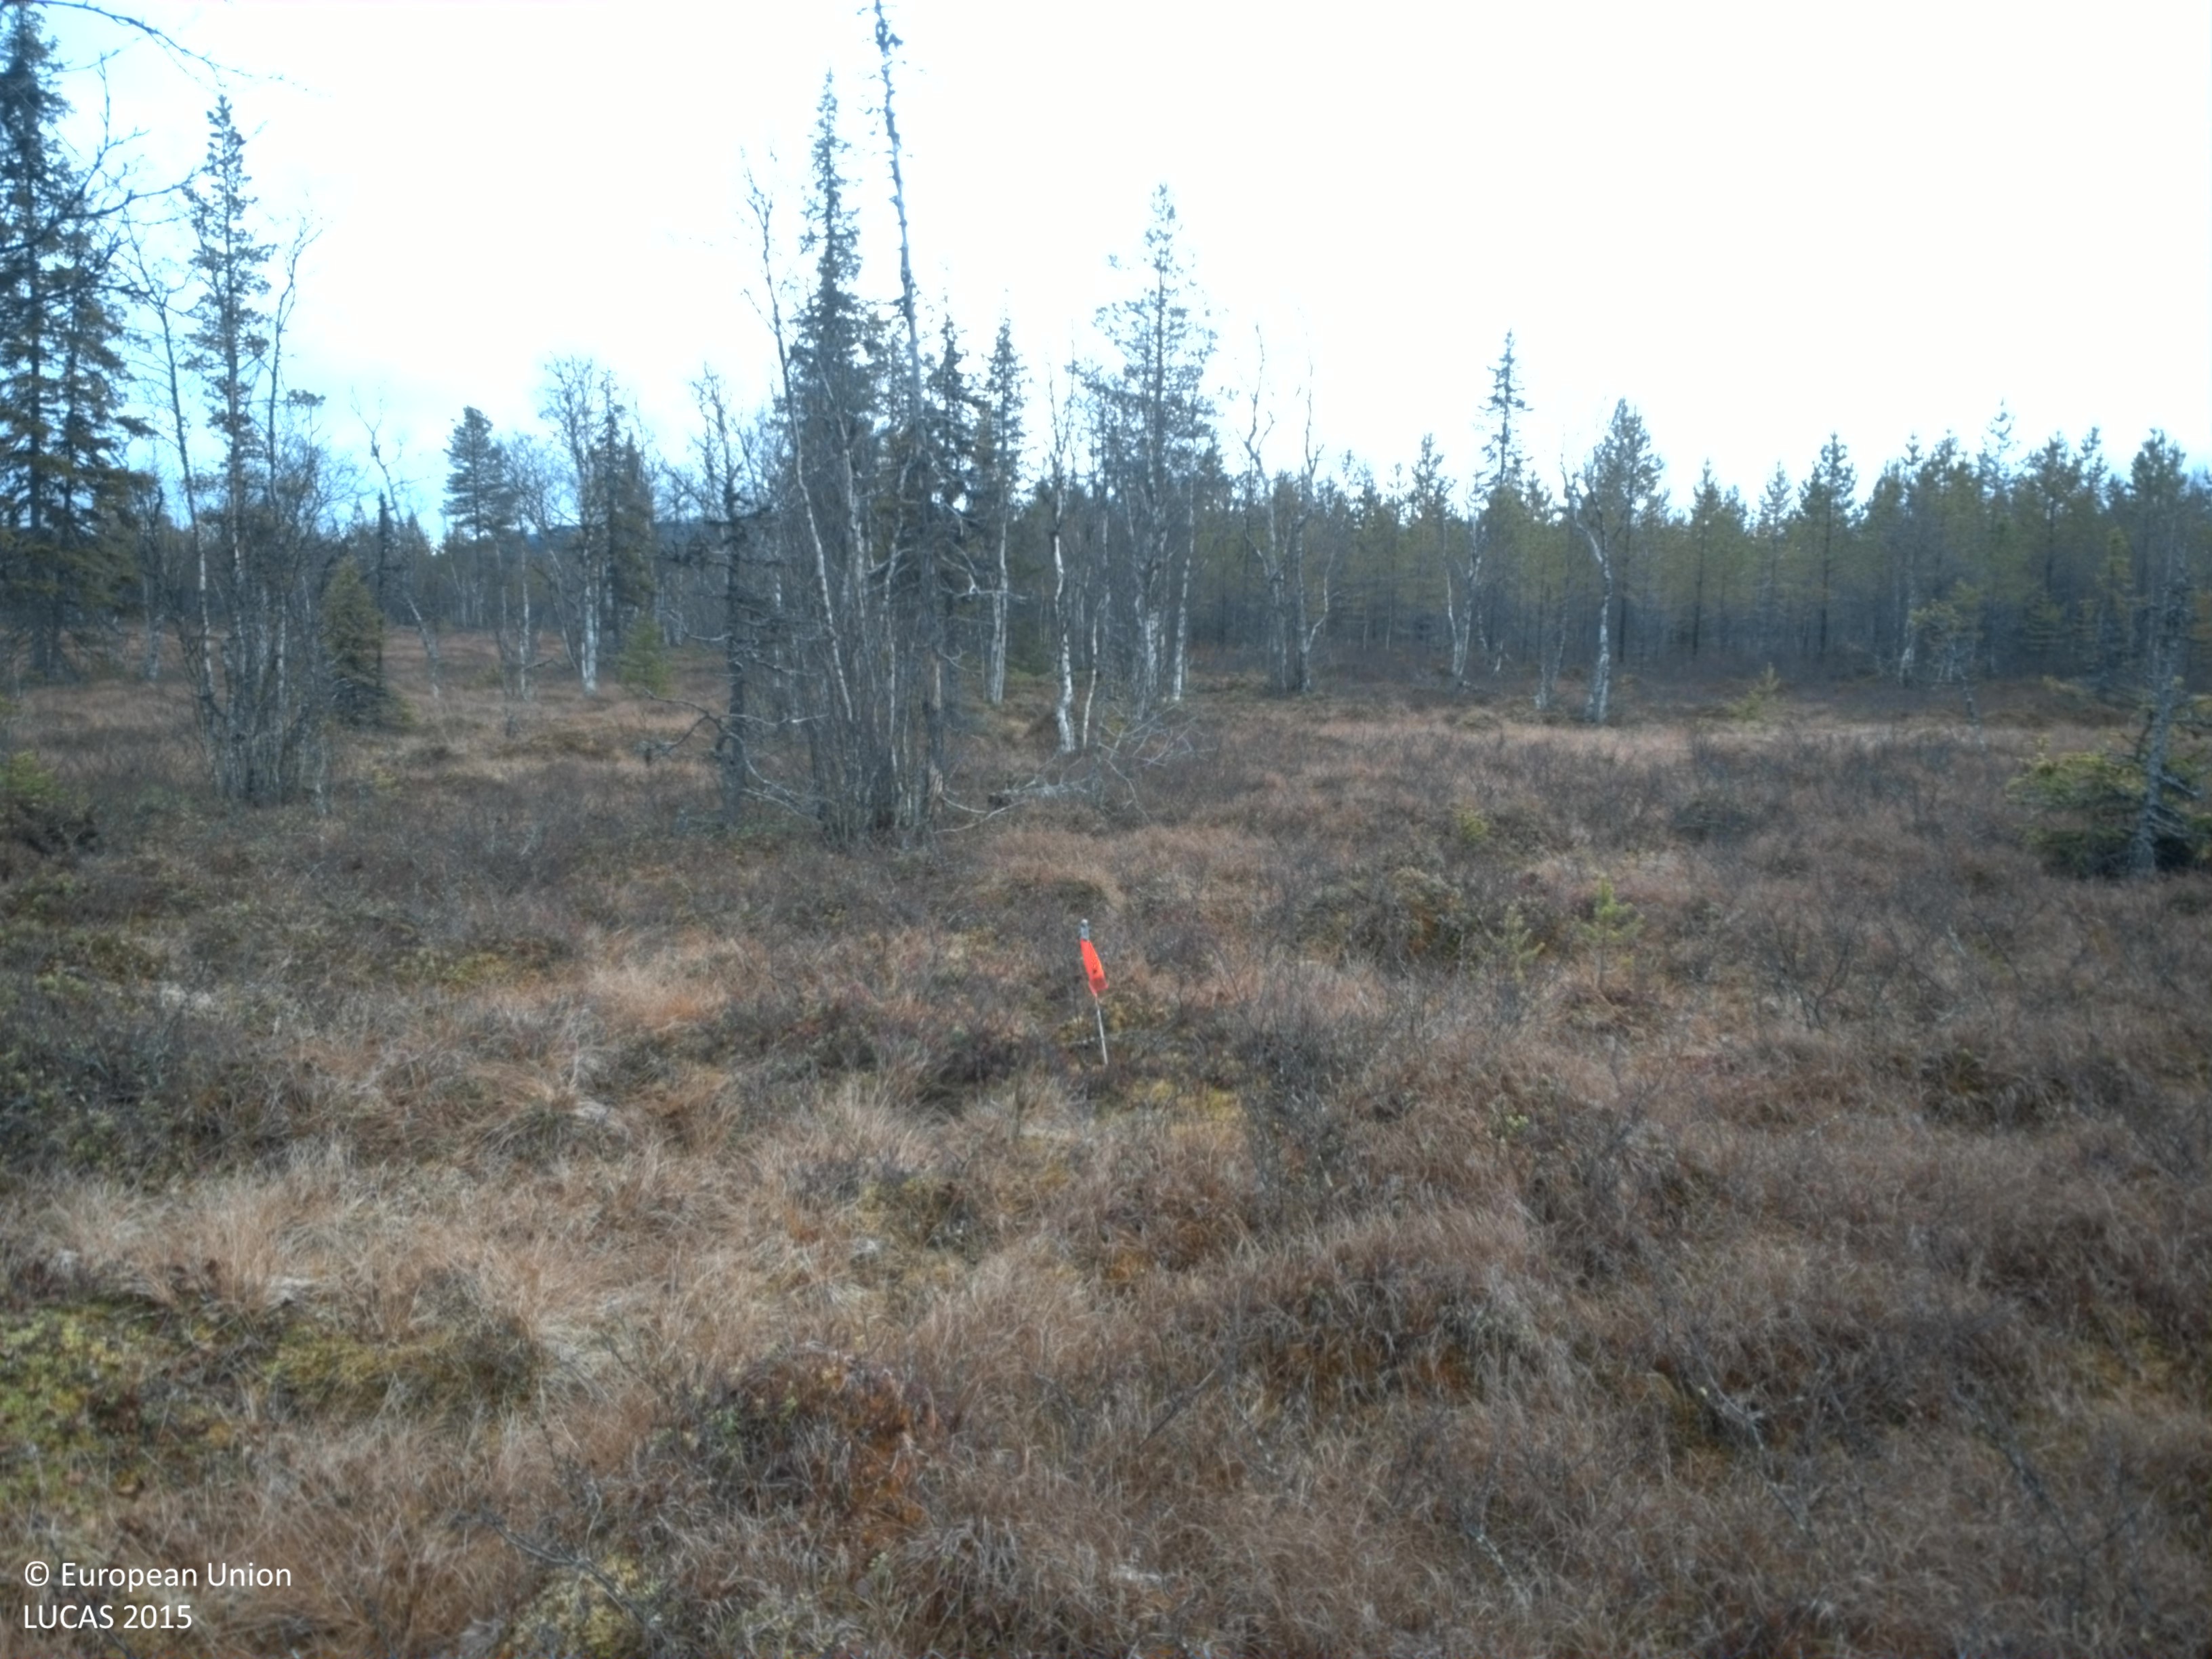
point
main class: Shrubland
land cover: Shrubland with sparse tree cover
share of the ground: 25 - 50 %
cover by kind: herbaceous plants 45 %, shrubs 25 %, lichens and mosses 25 %, coniferous forest trees 5 %
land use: Semi-natural and natural areas not in use
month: October
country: SE
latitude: 64.4760
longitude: 17.4762
